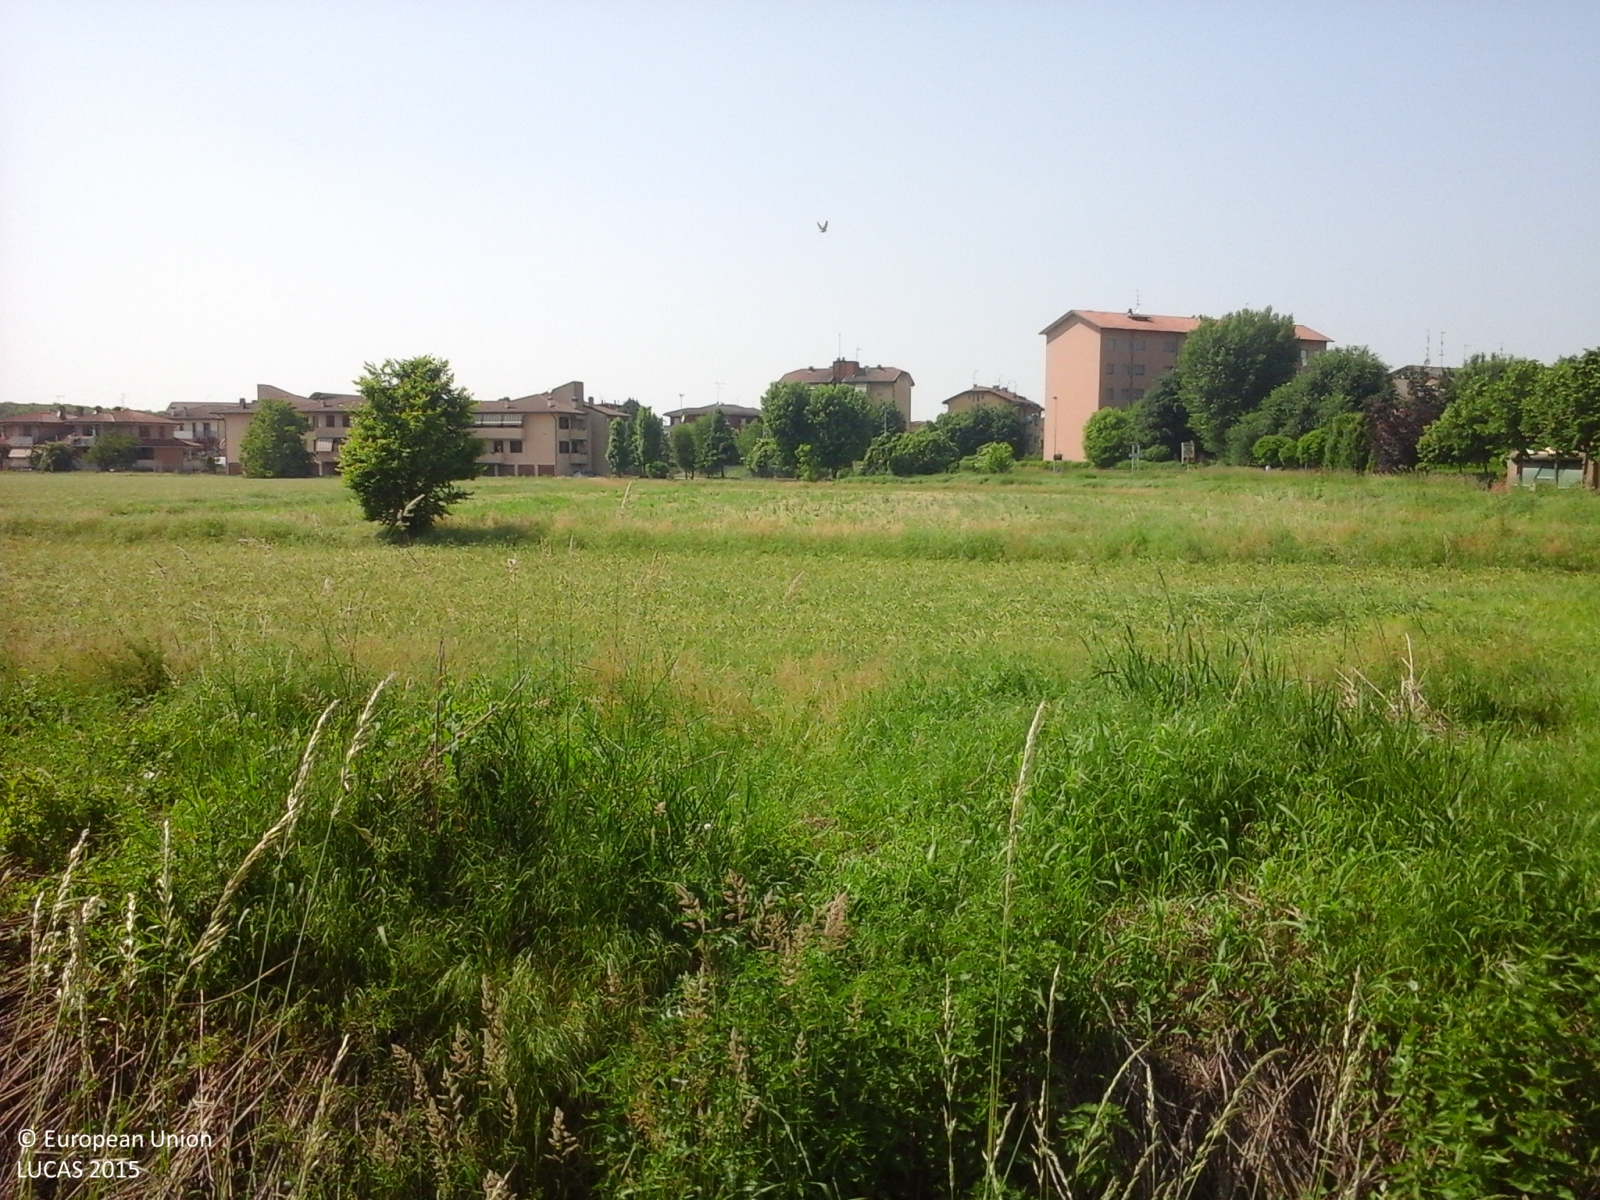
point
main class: Cropland
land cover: Barley
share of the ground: > 75 %
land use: Agriculture (excluding fallow land and kitchen gardens)
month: May
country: IT
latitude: 45.2323
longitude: 9.4024
